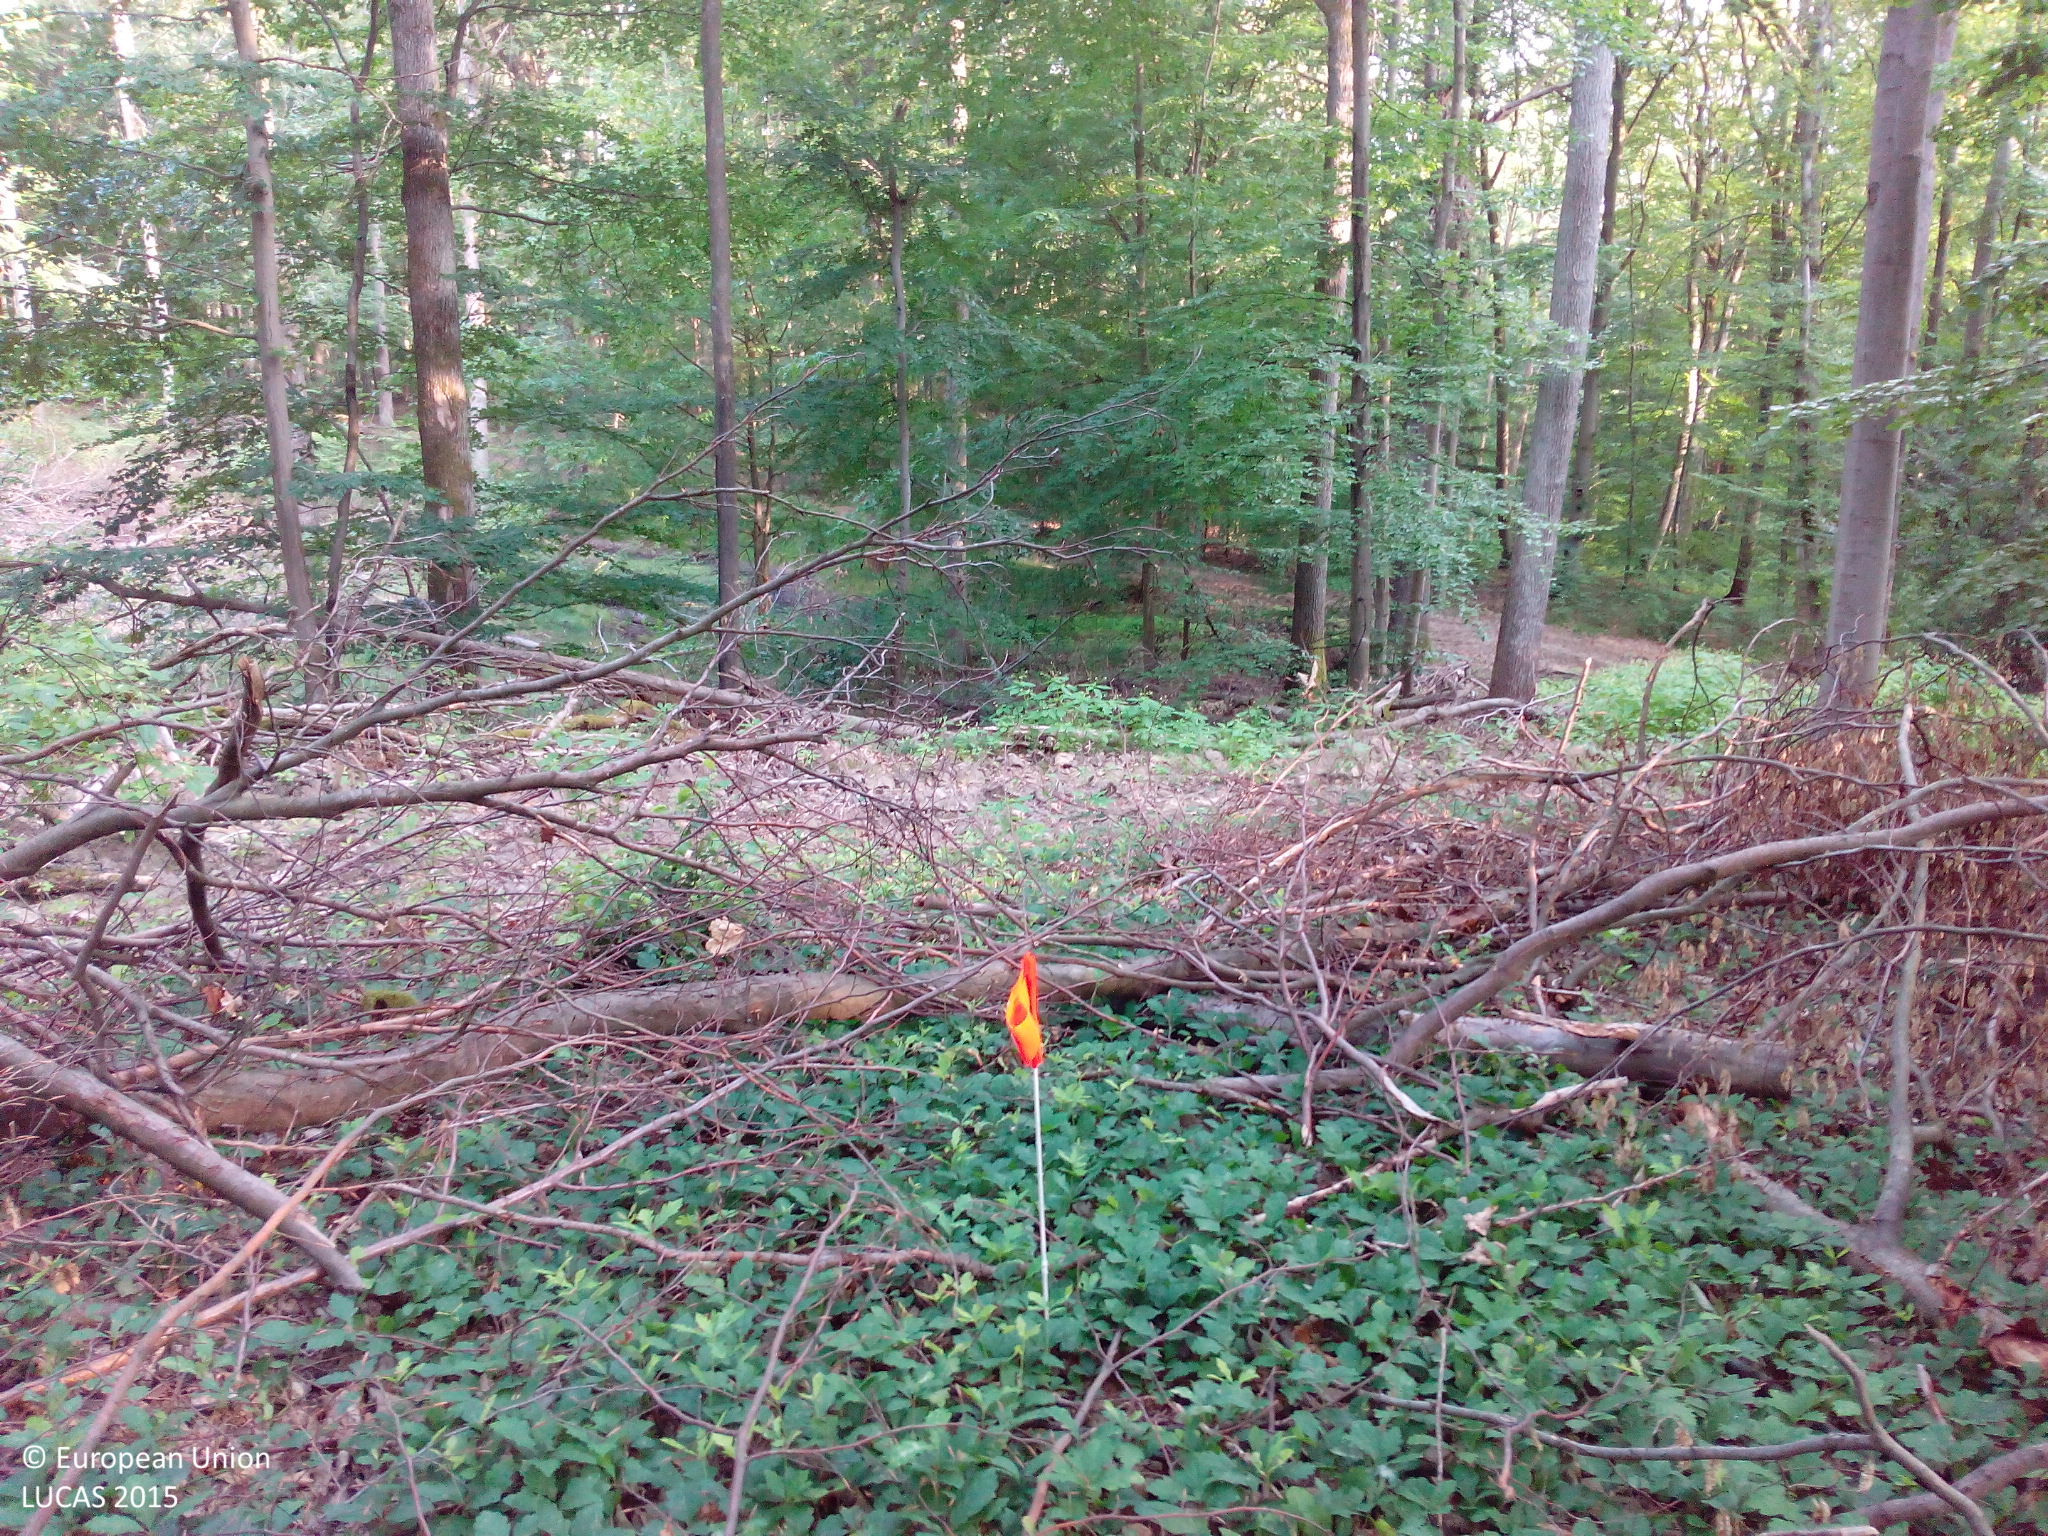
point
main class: Woodland
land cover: Broadleaved woodland
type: mesophytic deciduous forest
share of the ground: > 75 %
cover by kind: broadleaved forest trees 80 %, herbaceous plants 15 %, unconsolidated bare surface 5 %
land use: Forestry
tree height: > 5 m
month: July
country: DE
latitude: 49.8389
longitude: 10.9035
